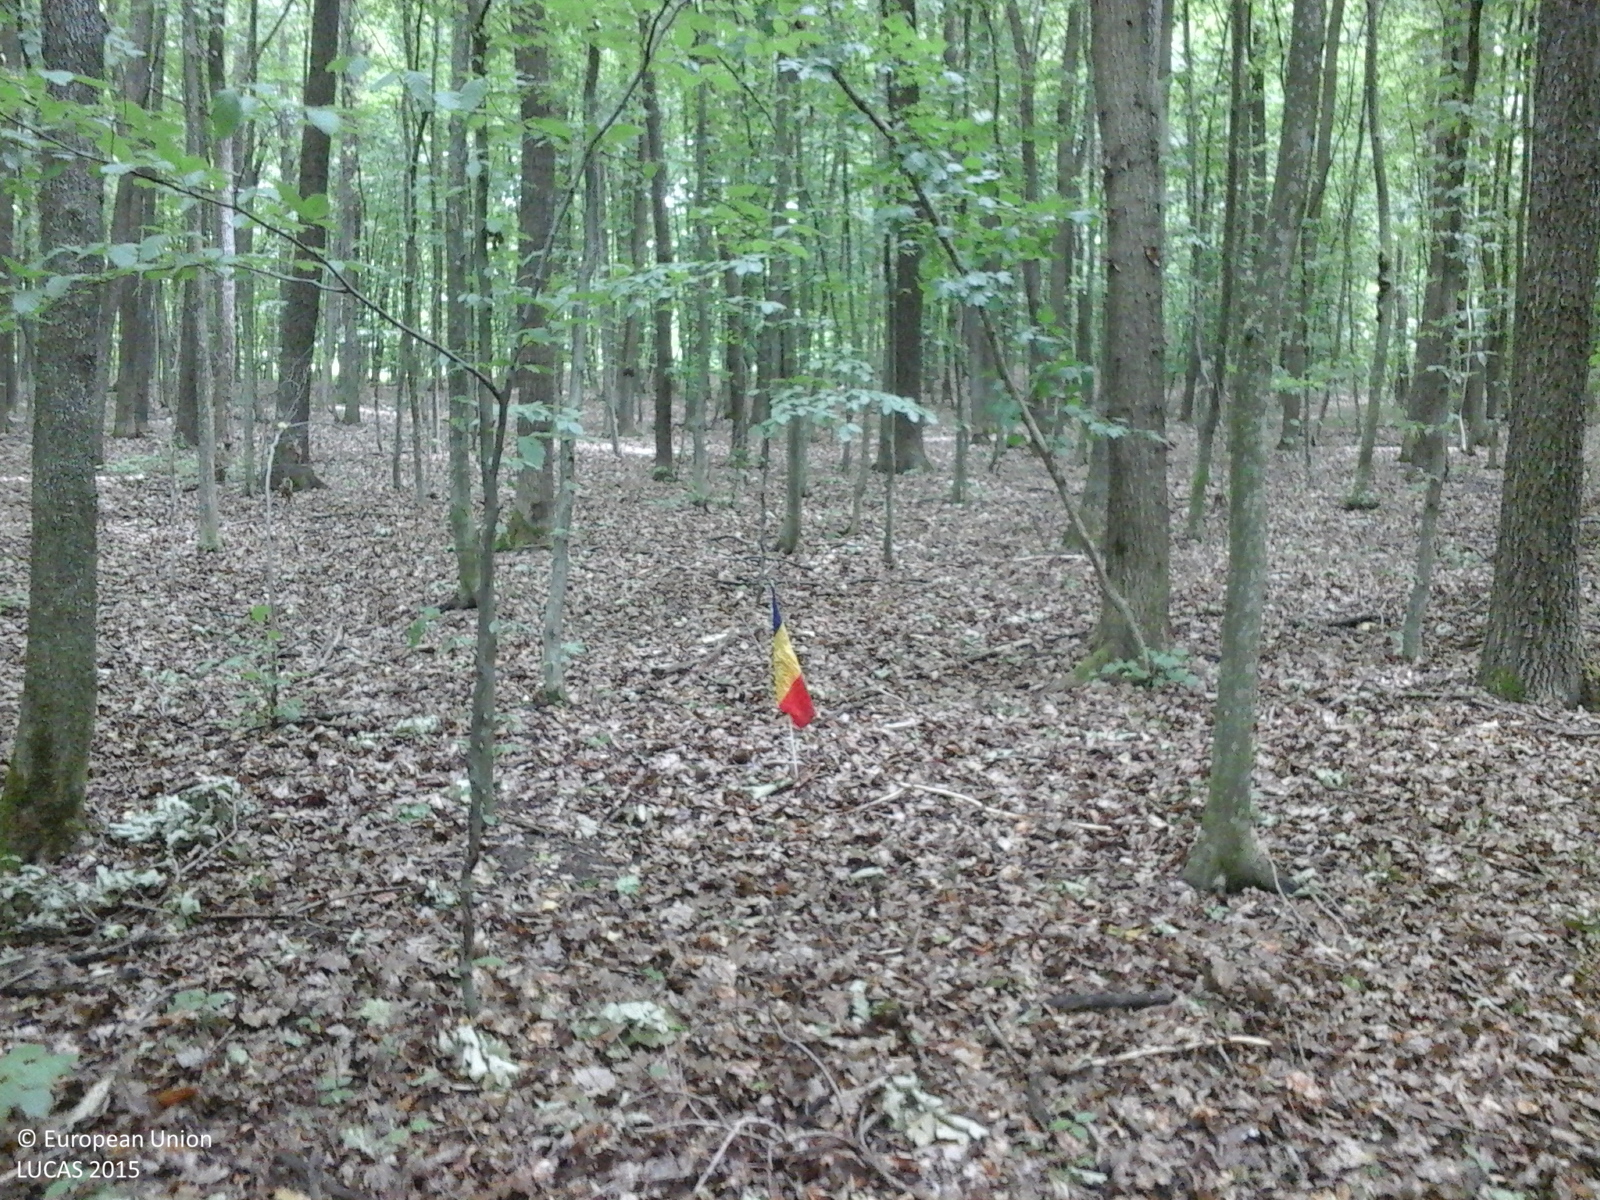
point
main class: Woodland
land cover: Broadleaved woodland
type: beech forest
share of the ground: > 75 %
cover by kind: broadleaved forest trees 100 %
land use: Forestry
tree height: > 5 m
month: June
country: RO
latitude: 47.4003
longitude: 26.5599
